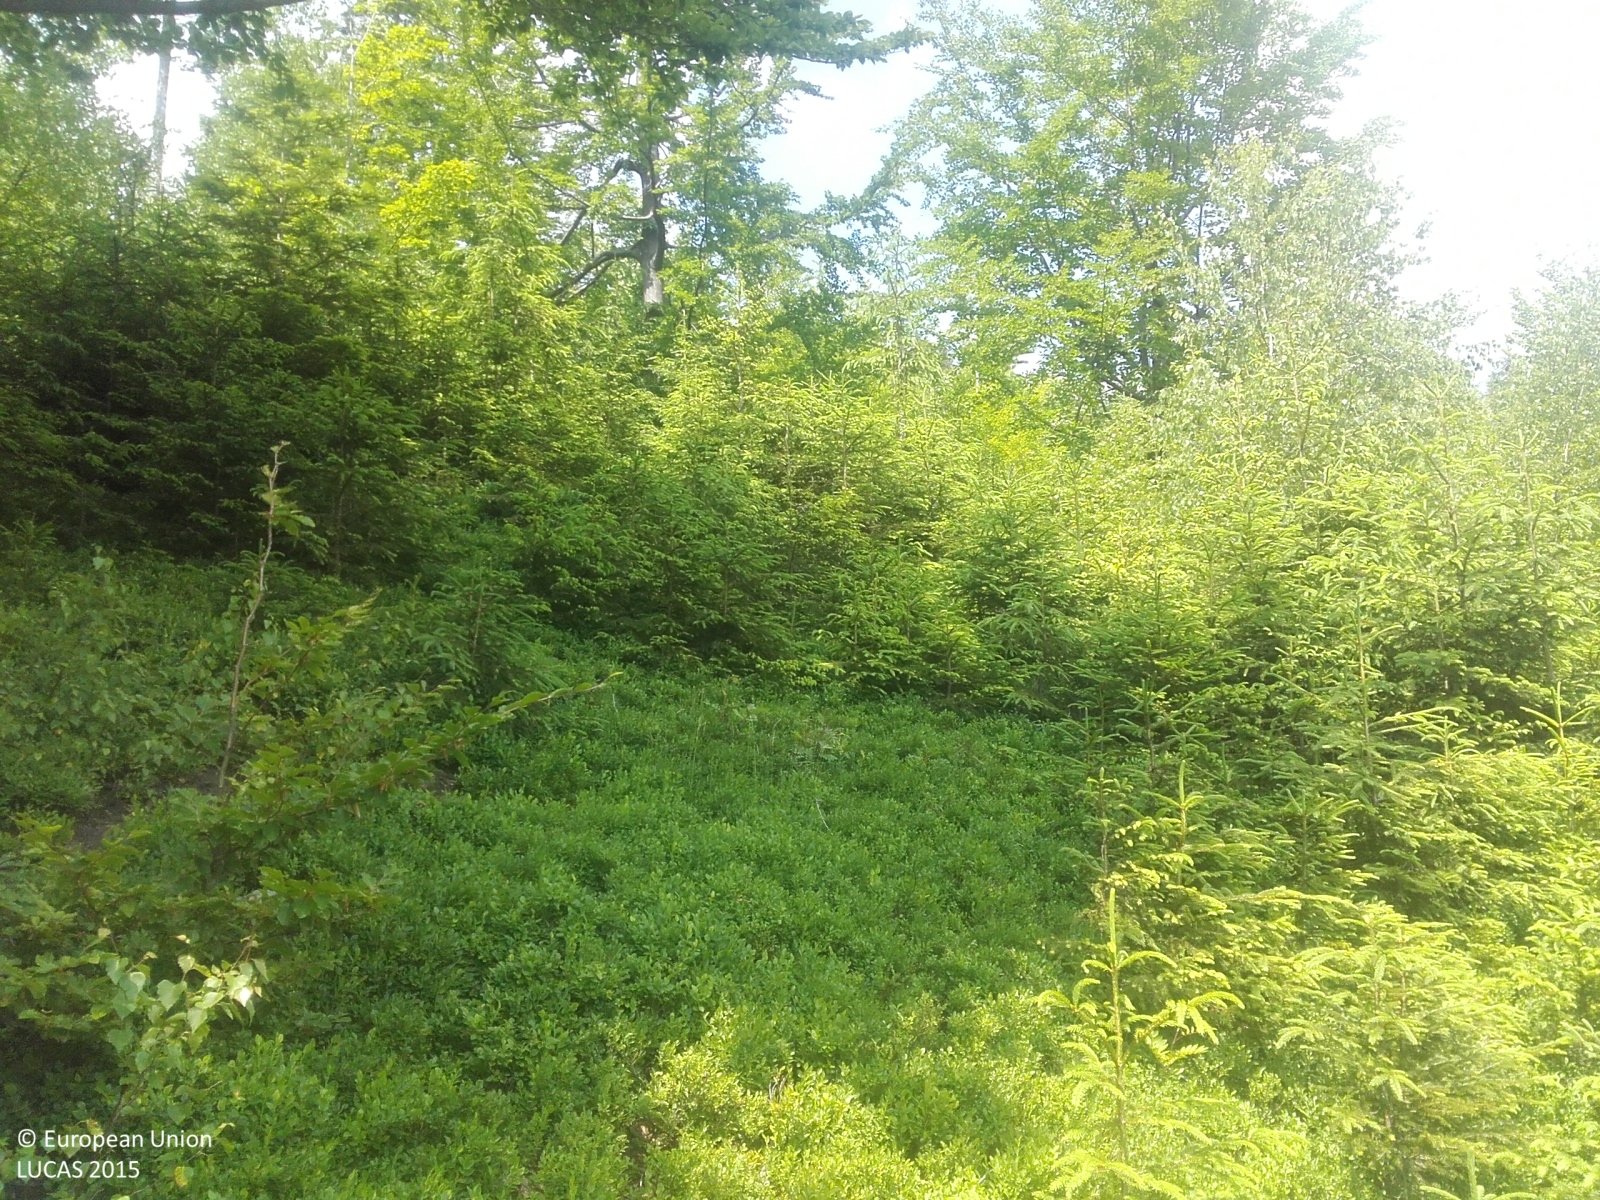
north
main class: Woodland
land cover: Spruce dominated coniferous woodland
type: hemiboreal forest and nemoral coniferous forest and mixed broadleaved-coniferous forest
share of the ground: > 75 %
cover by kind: coniferous forest trees 75 %, shrubs 10 %, herbaceous plants 10 %, broadleaved forest trees 5 %
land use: Forestry
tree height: > 5 m
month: June
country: CZ
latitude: 49.5876
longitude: 18.8326
